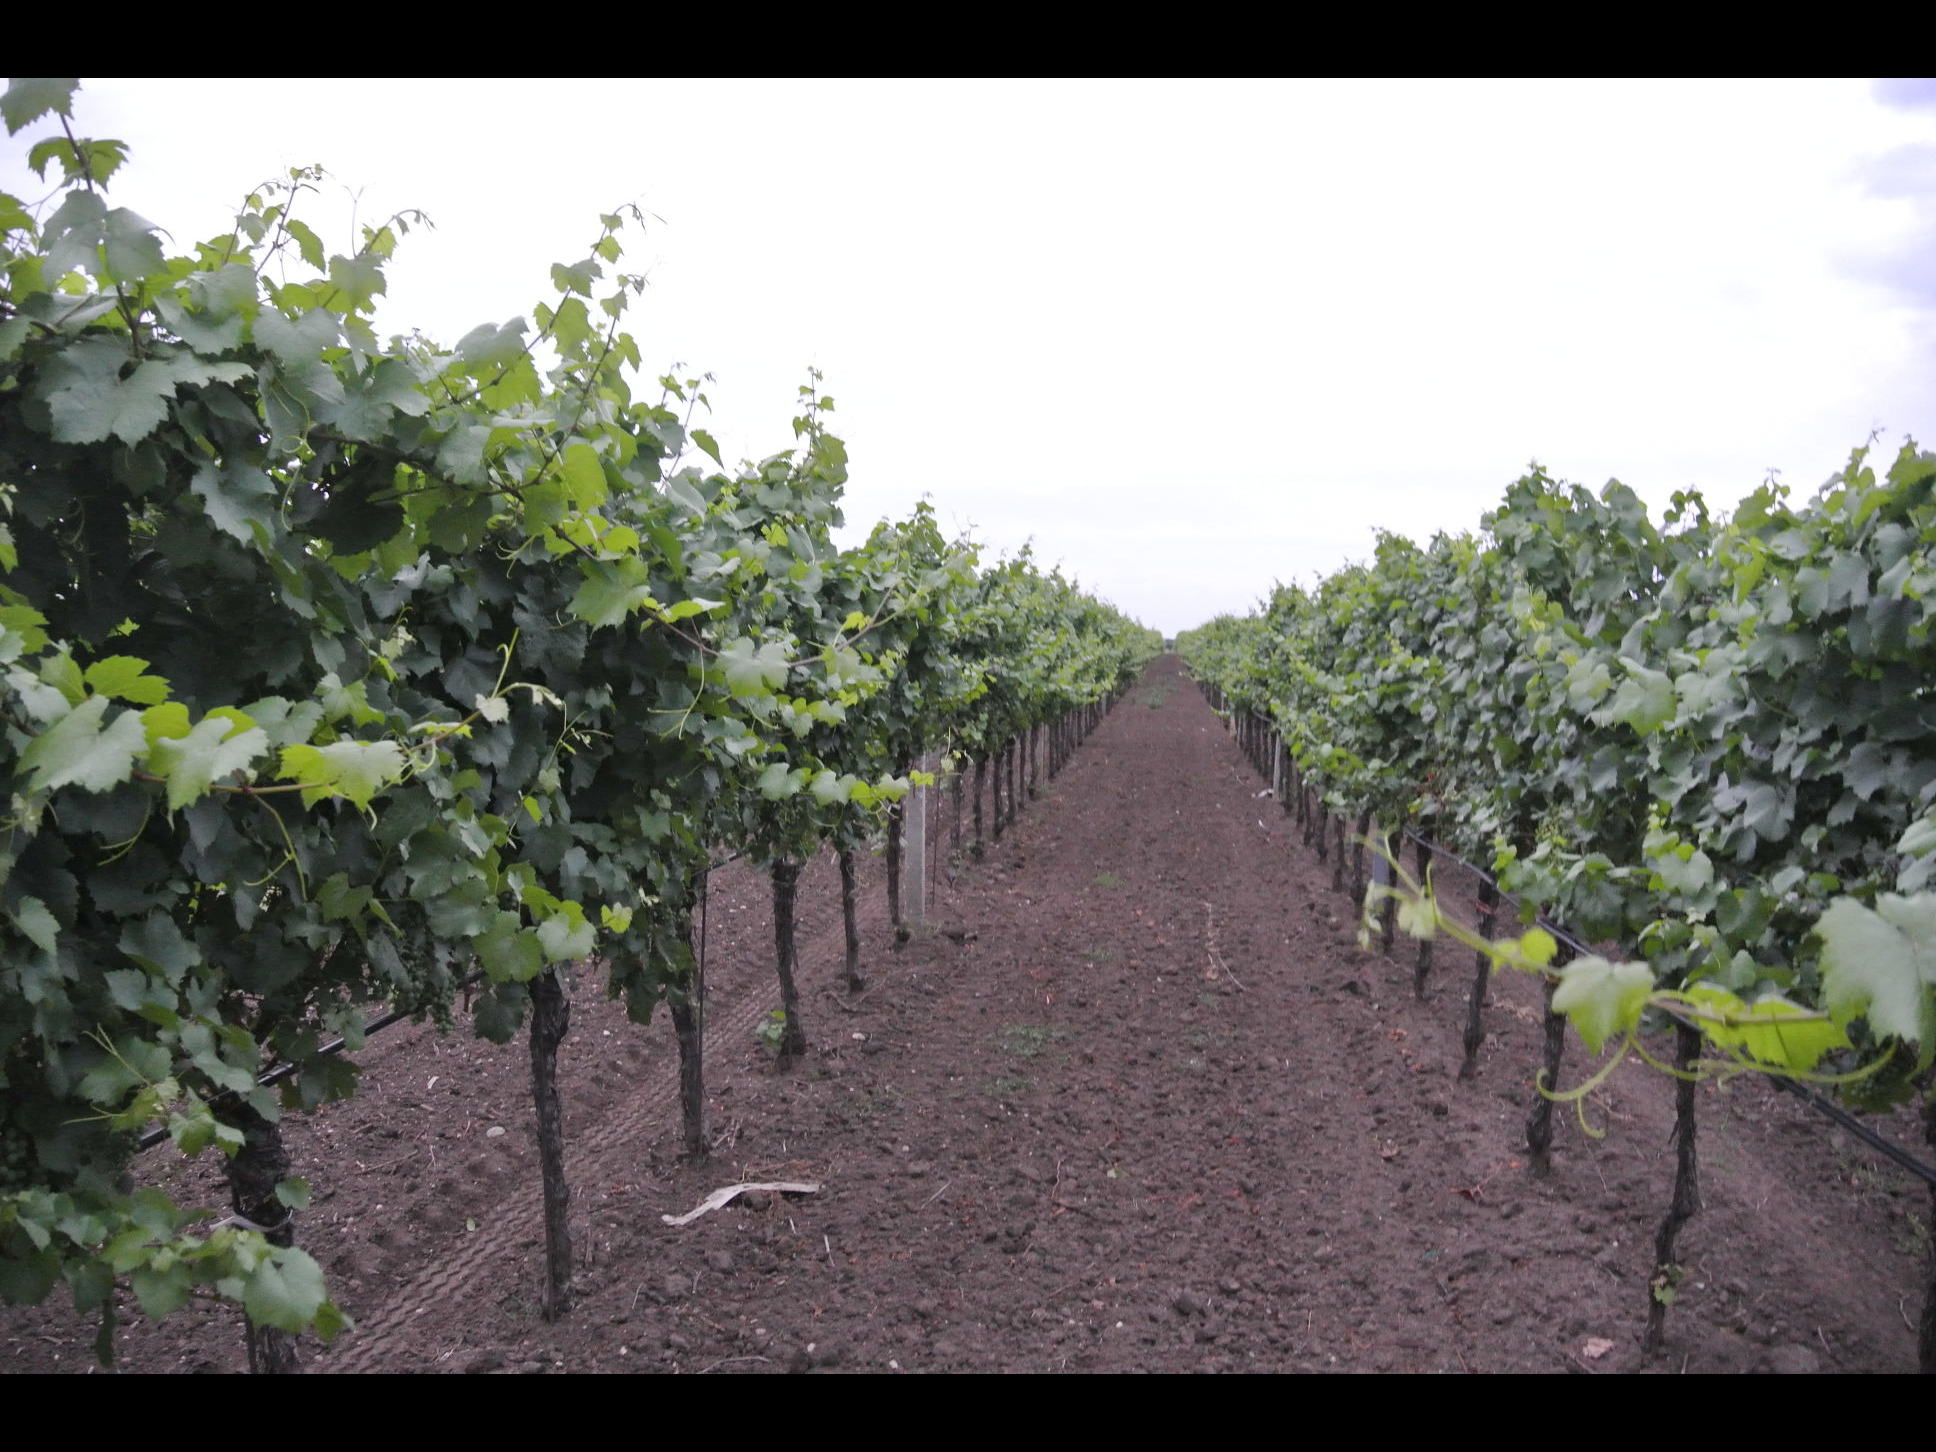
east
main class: Cropland
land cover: Vineyards
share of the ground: 25 - 50 %
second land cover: Other bare soil
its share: > 75 %
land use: Agriculture (excluding fallow land and kitchen gardens)
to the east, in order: Vineyards; Other bare soil; Grass margins; Paved roads, cycling and walking lanes; Grass margins; Vineyards
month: July
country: AT
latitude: 47.7967
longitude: 16.8011
